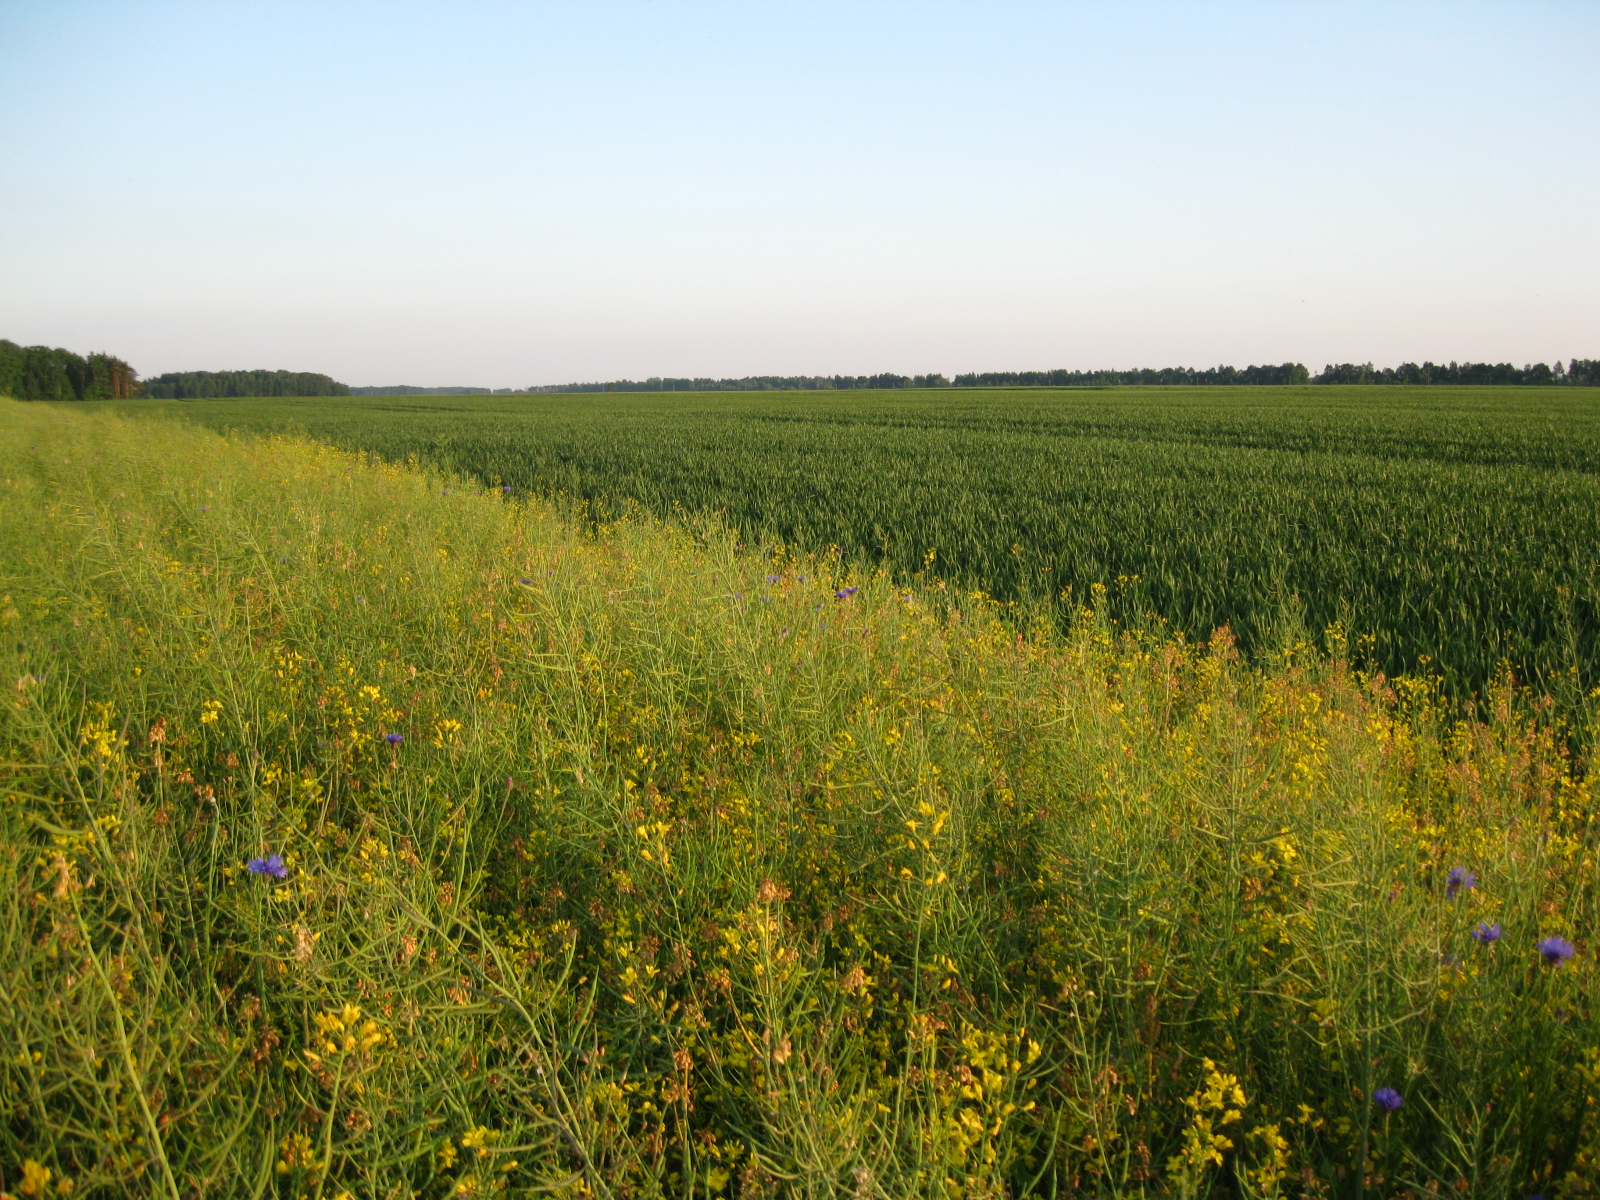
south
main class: Cropland
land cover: Rape and turnip rape
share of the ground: > 75 %
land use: Agriculture (excluding fallow land and kitchen gardens)
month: June
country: LT
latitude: 55.5088
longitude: 23.8135
